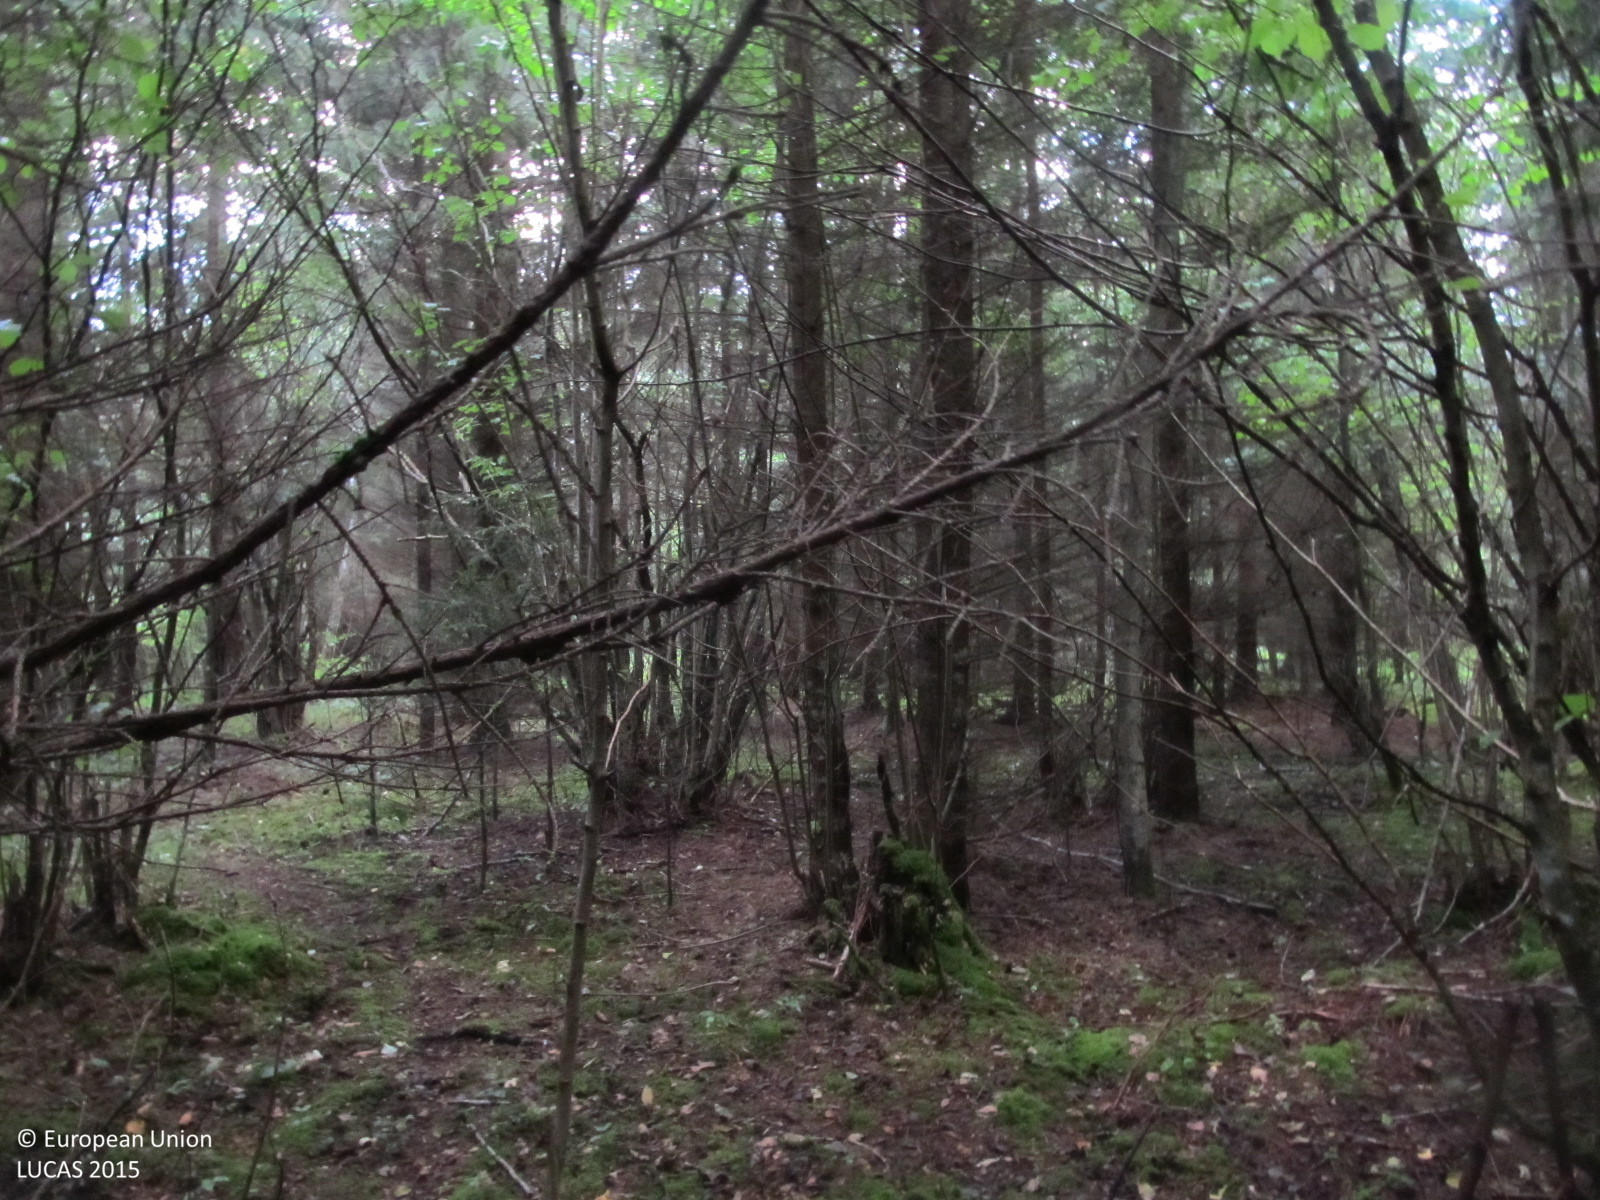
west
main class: Woodland
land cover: Spruce dominated mixed woodland
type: hemiboreal forest and nemoral coniferous forest and mixed broadleaved-coniferous forest
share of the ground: > 75 %
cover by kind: coniferous forest trees 55 %, broadleaved forest trees 40 %, lichens and mosses 5 %
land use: Forestry
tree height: > 5 m
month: September
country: LT
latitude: 56.2189
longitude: 23.1479
